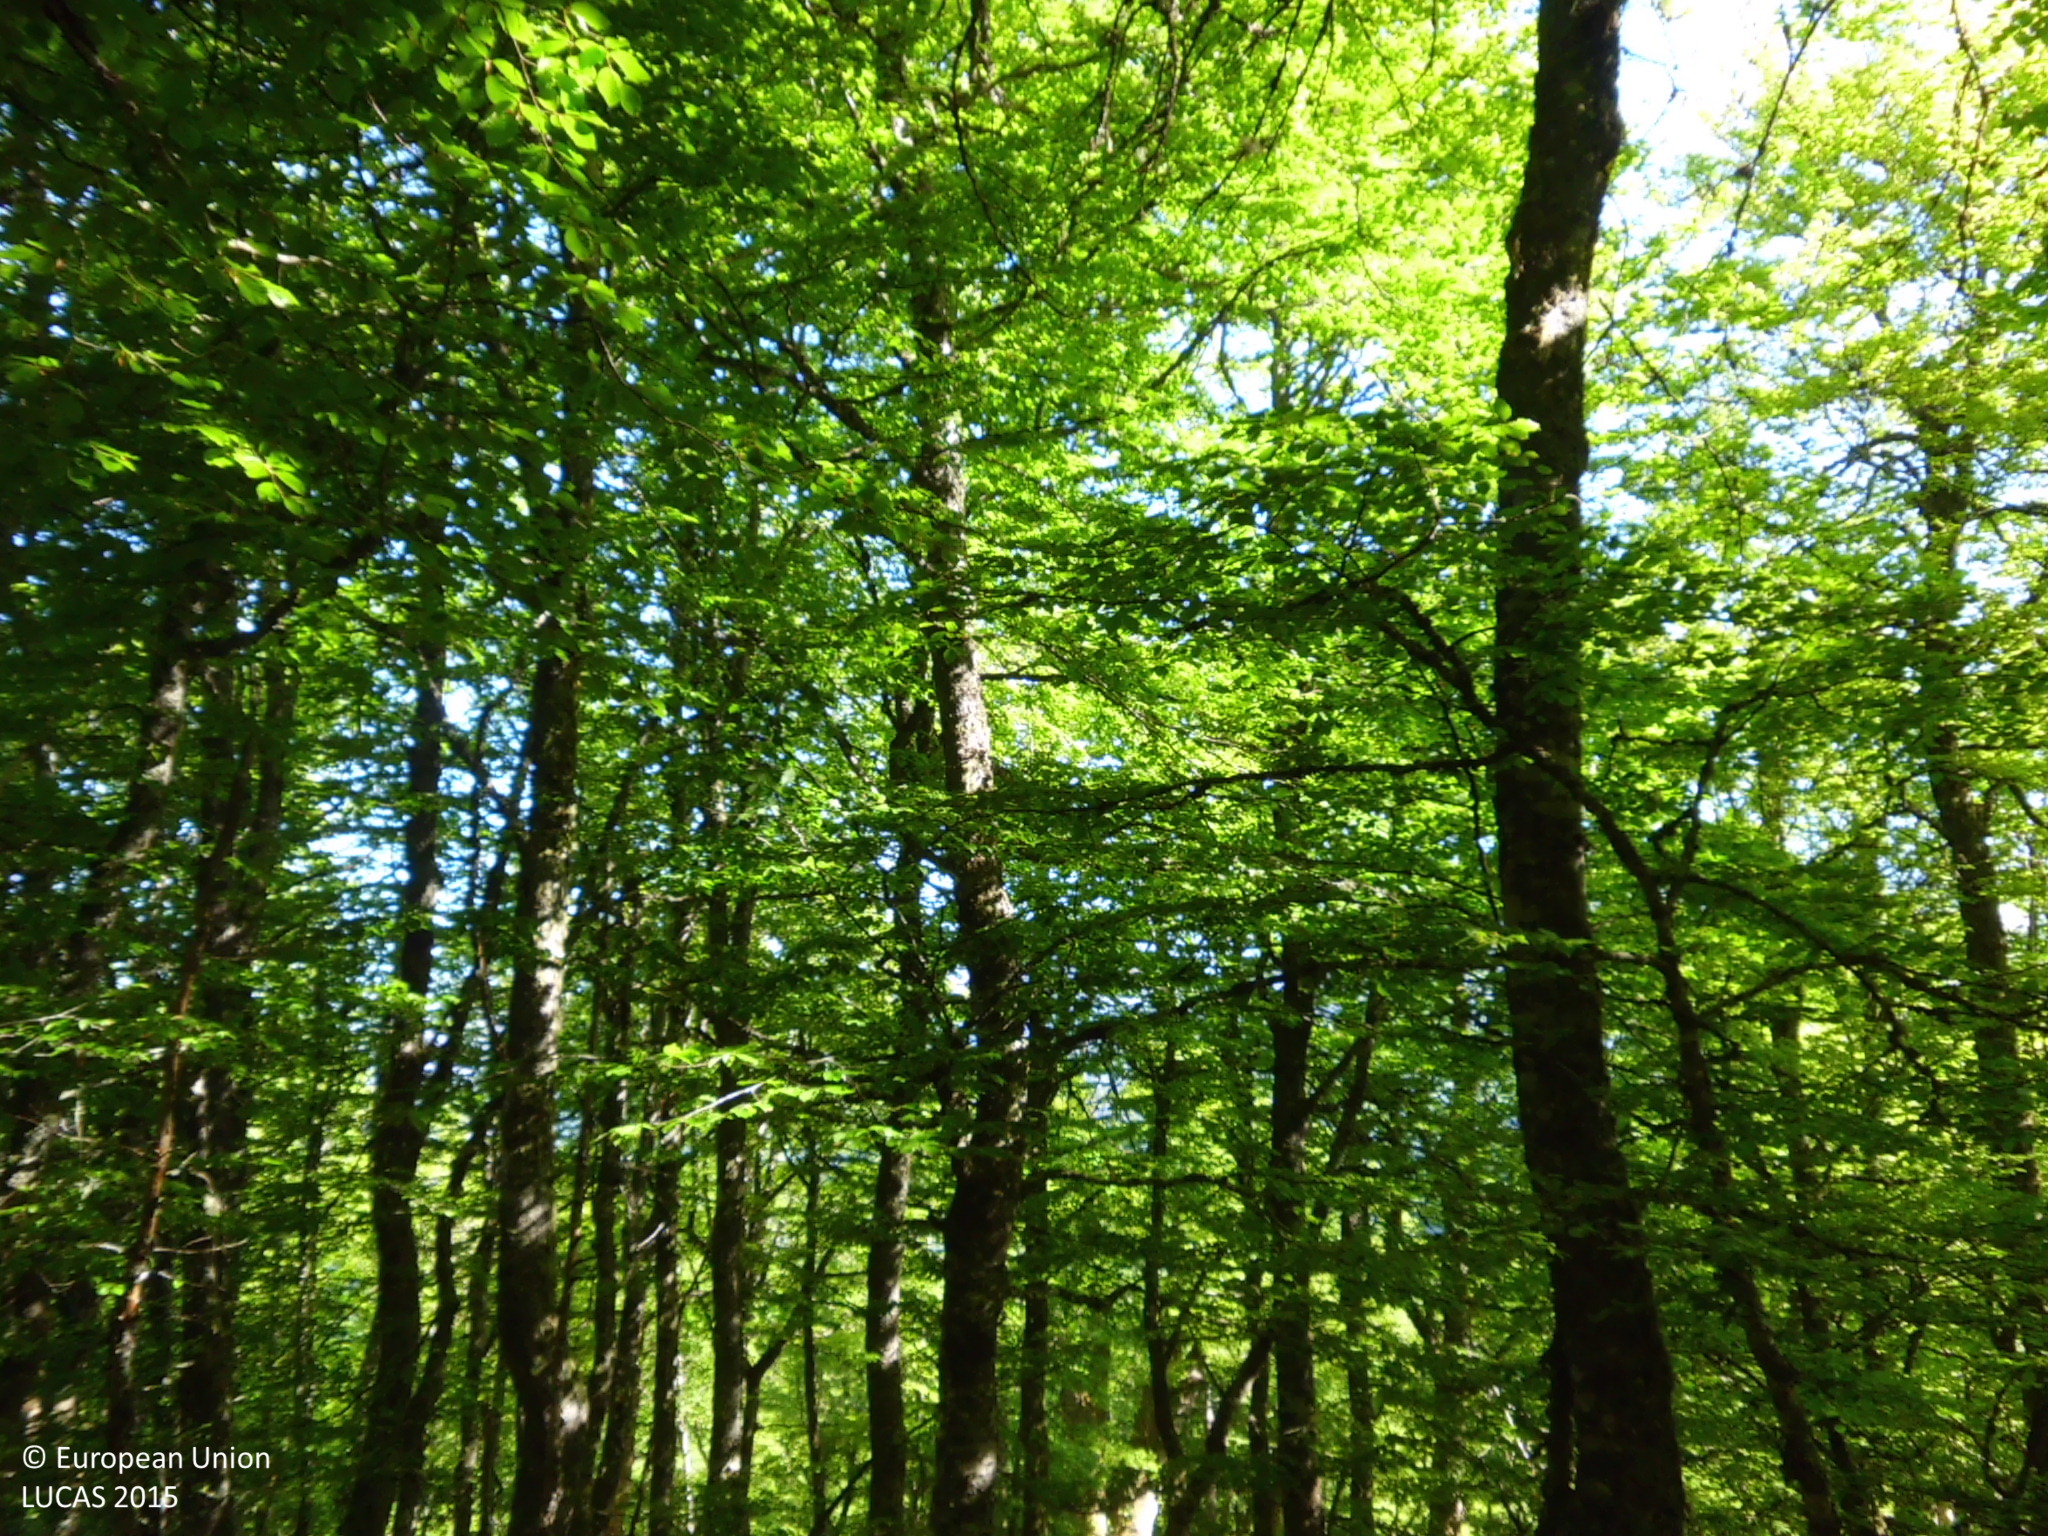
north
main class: Woodland
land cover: Broadleaved woodland
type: mountainous beech forest
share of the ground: 50 - 75 %
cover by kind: broadleaved forest trees 70 %, herbaceous plants 25 %, shrubs 5 %
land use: Semi-natural and natural areas not in use
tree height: > 5 m
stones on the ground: > 50 %
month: May
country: ES
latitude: 43.1032
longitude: -5.0210
